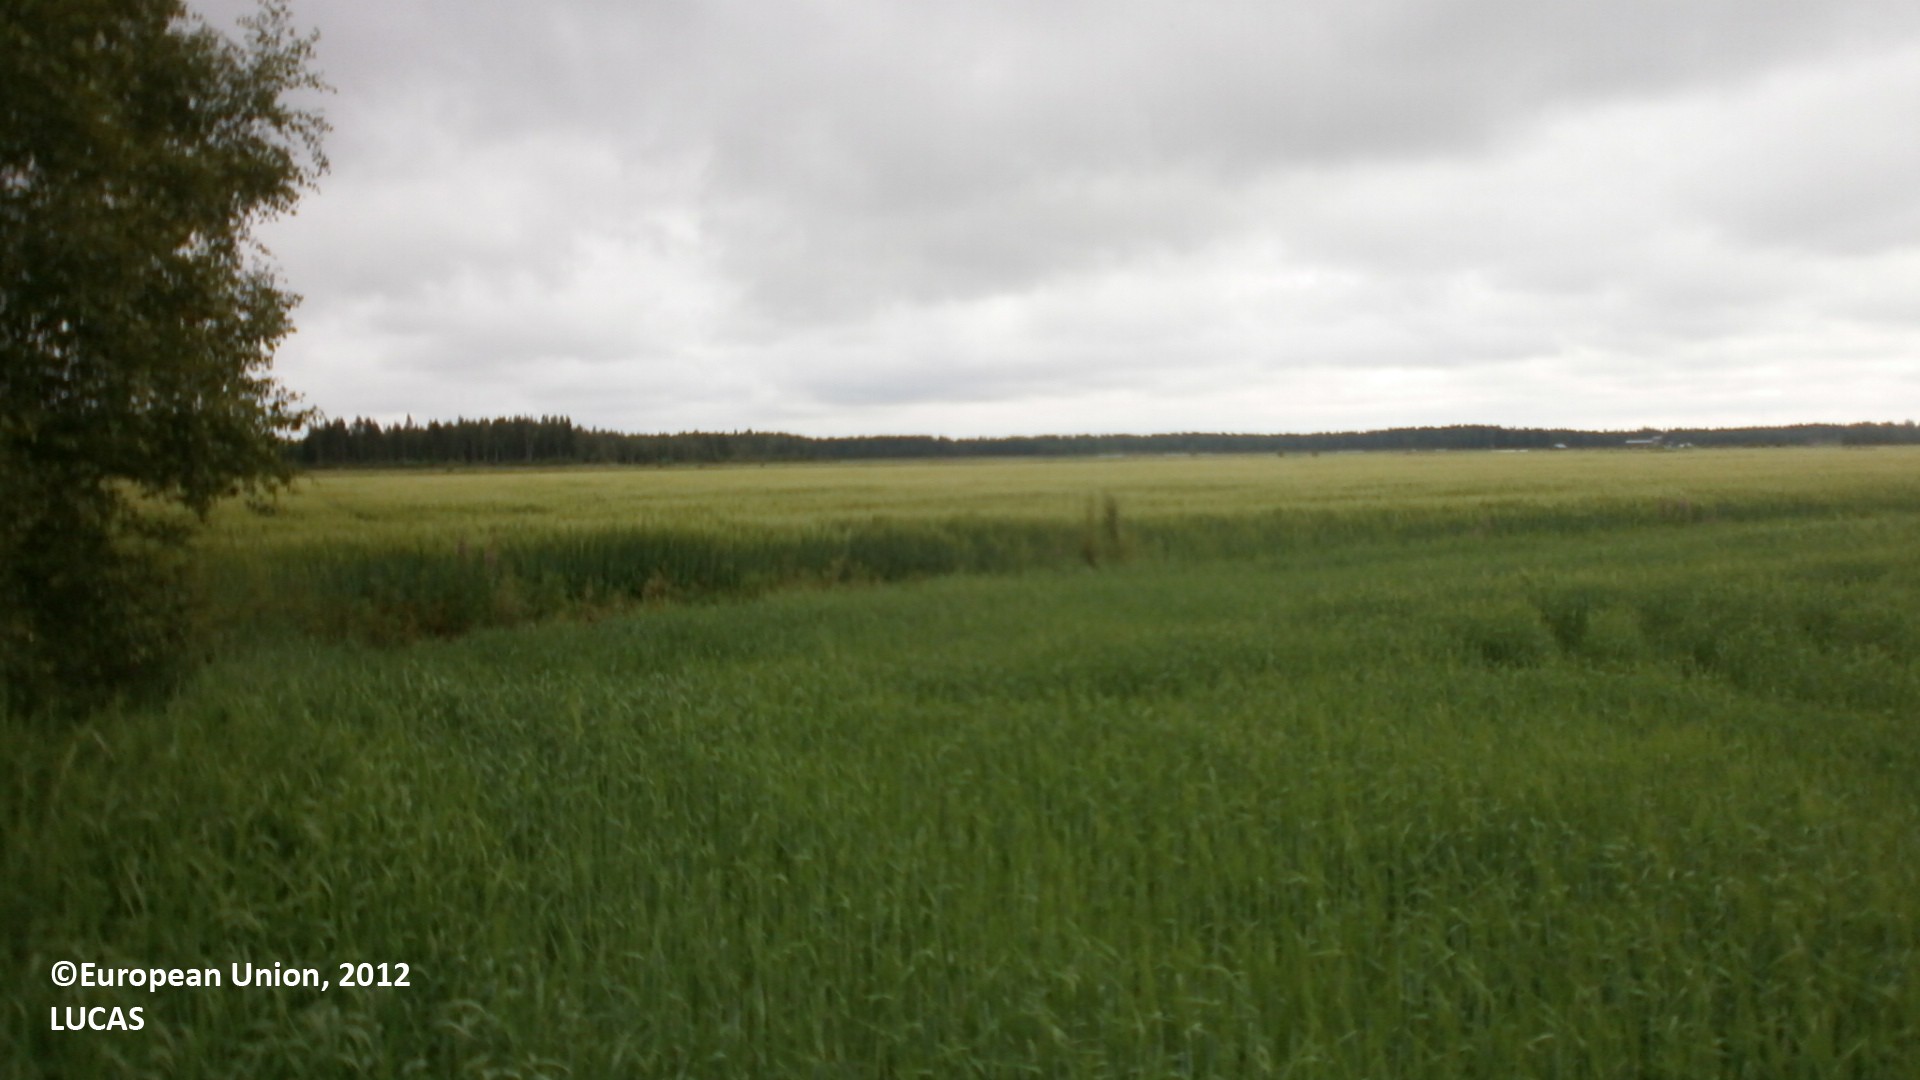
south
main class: Cropland
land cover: Barley
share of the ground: > 75 %
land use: Agriculture (excluding fallow land and kitchen gardens)
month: July
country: FI
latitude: 64.2282
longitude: 24.0610
